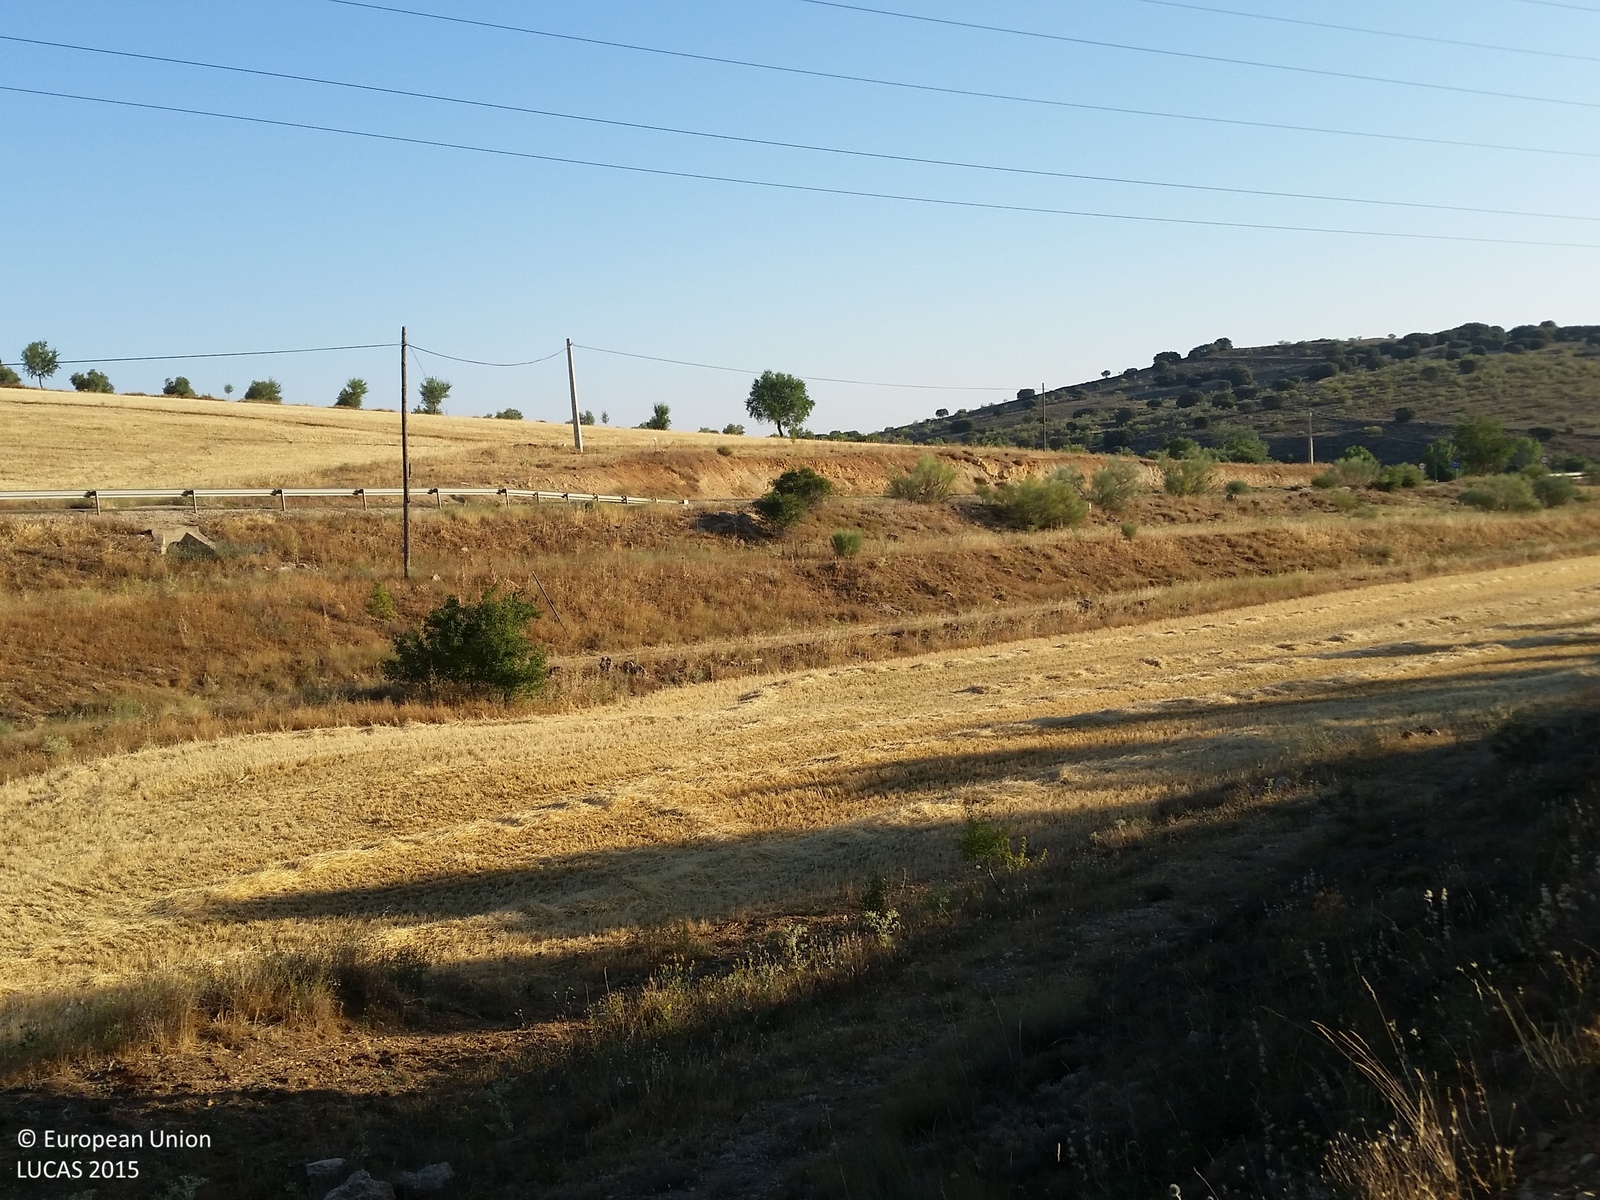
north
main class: Cropland
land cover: Nuts trees
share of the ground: > 75 %
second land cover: Grassland without tree/shrub cover
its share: 25 - 50 %
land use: Agriculture (excluding fallow land and kitchen gardens)
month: July
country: ES
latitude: 38.9669
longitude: -2.5278
